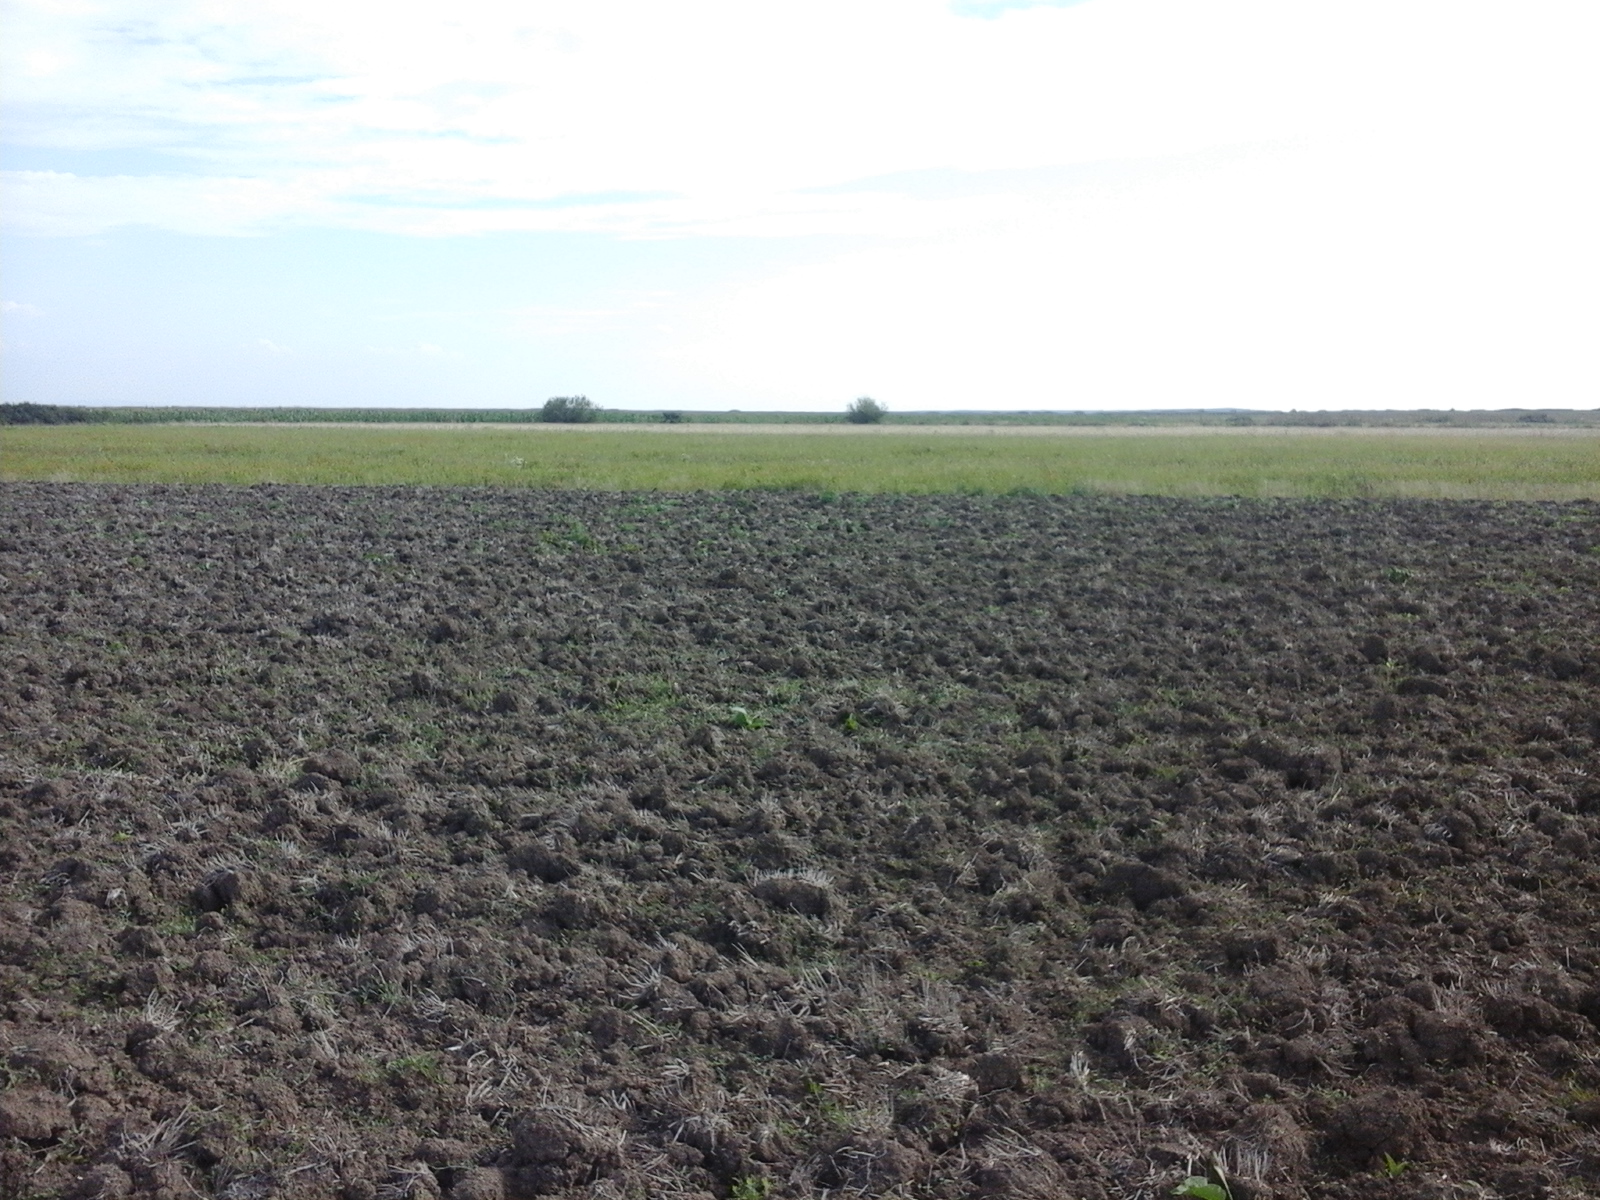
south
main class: Cropland
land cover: Common wheat
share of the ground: < 10 %
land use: Agriculture (excluding fallow land and kitchen gardens)
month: August
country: RO
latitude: 46.6412
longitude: 21.4692
